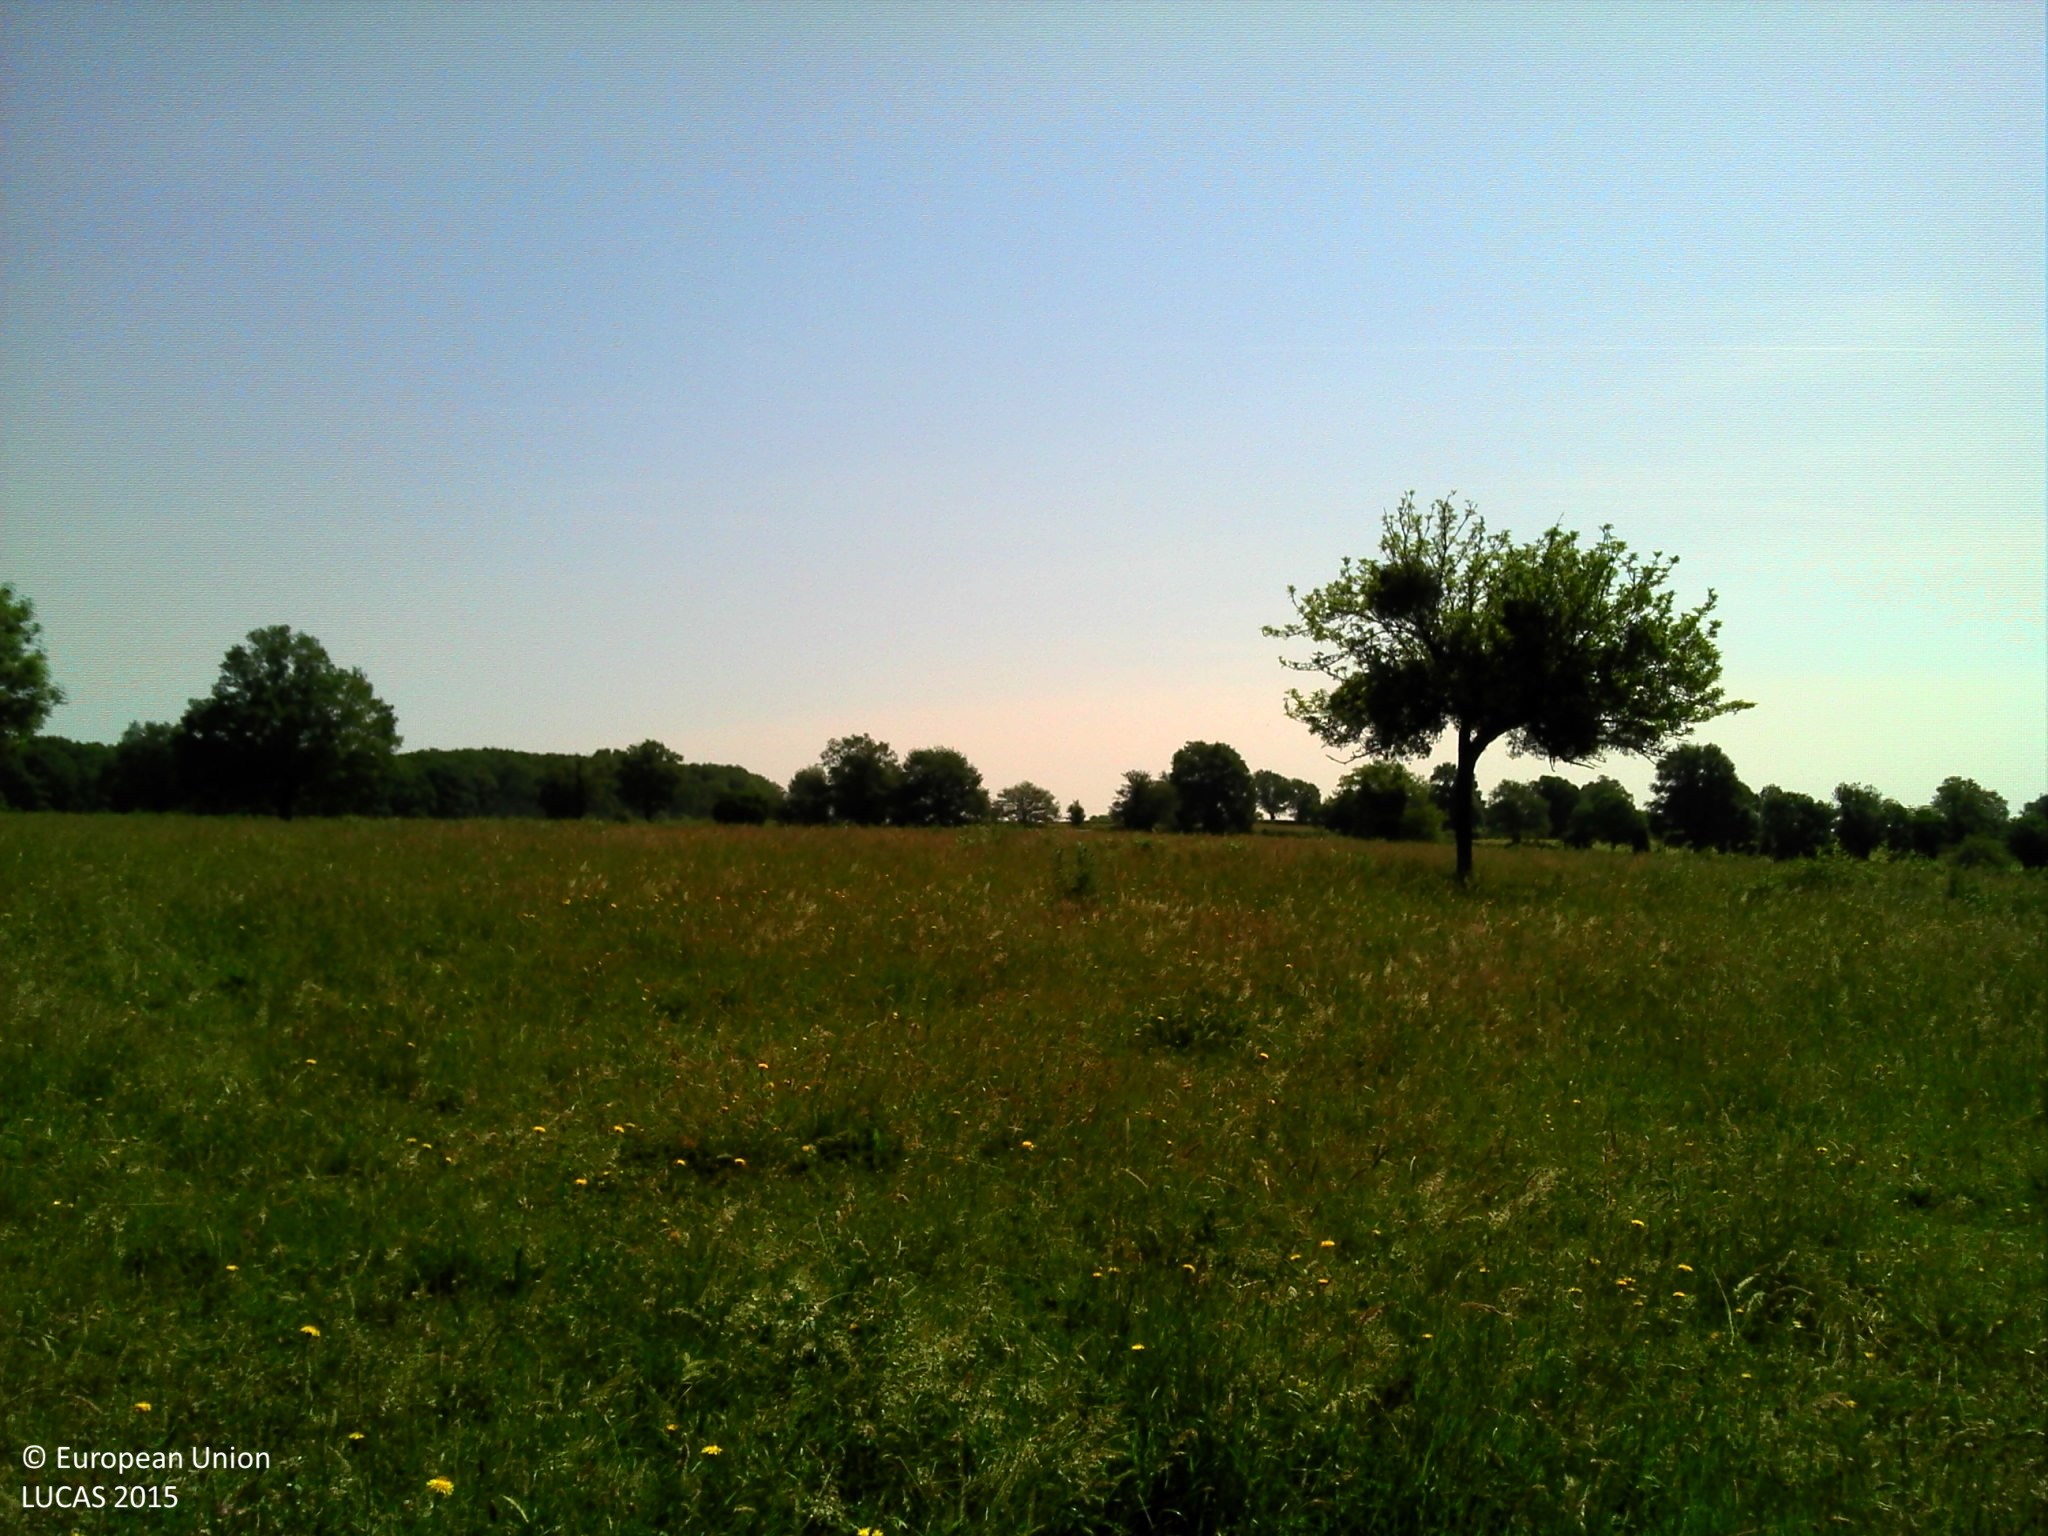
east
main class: Grassland
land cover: Grassland without tree/shrub cover
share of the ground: > 75 %
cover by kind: herbaceous plants 100 %
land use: Agriculture (excluding fallow land and kitchen gardens)
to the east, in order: Grassland without tree/shrub cover; Managed hedges; Grassland without tree/shrub cover; Fences; Managed hedges; Grassland without tree/shrub cover; Fences; Managed hedges; Single bushes/trees; Grassland without tree/shrub cover
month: June
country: FR
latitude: 46.2350
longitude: 2.8003
